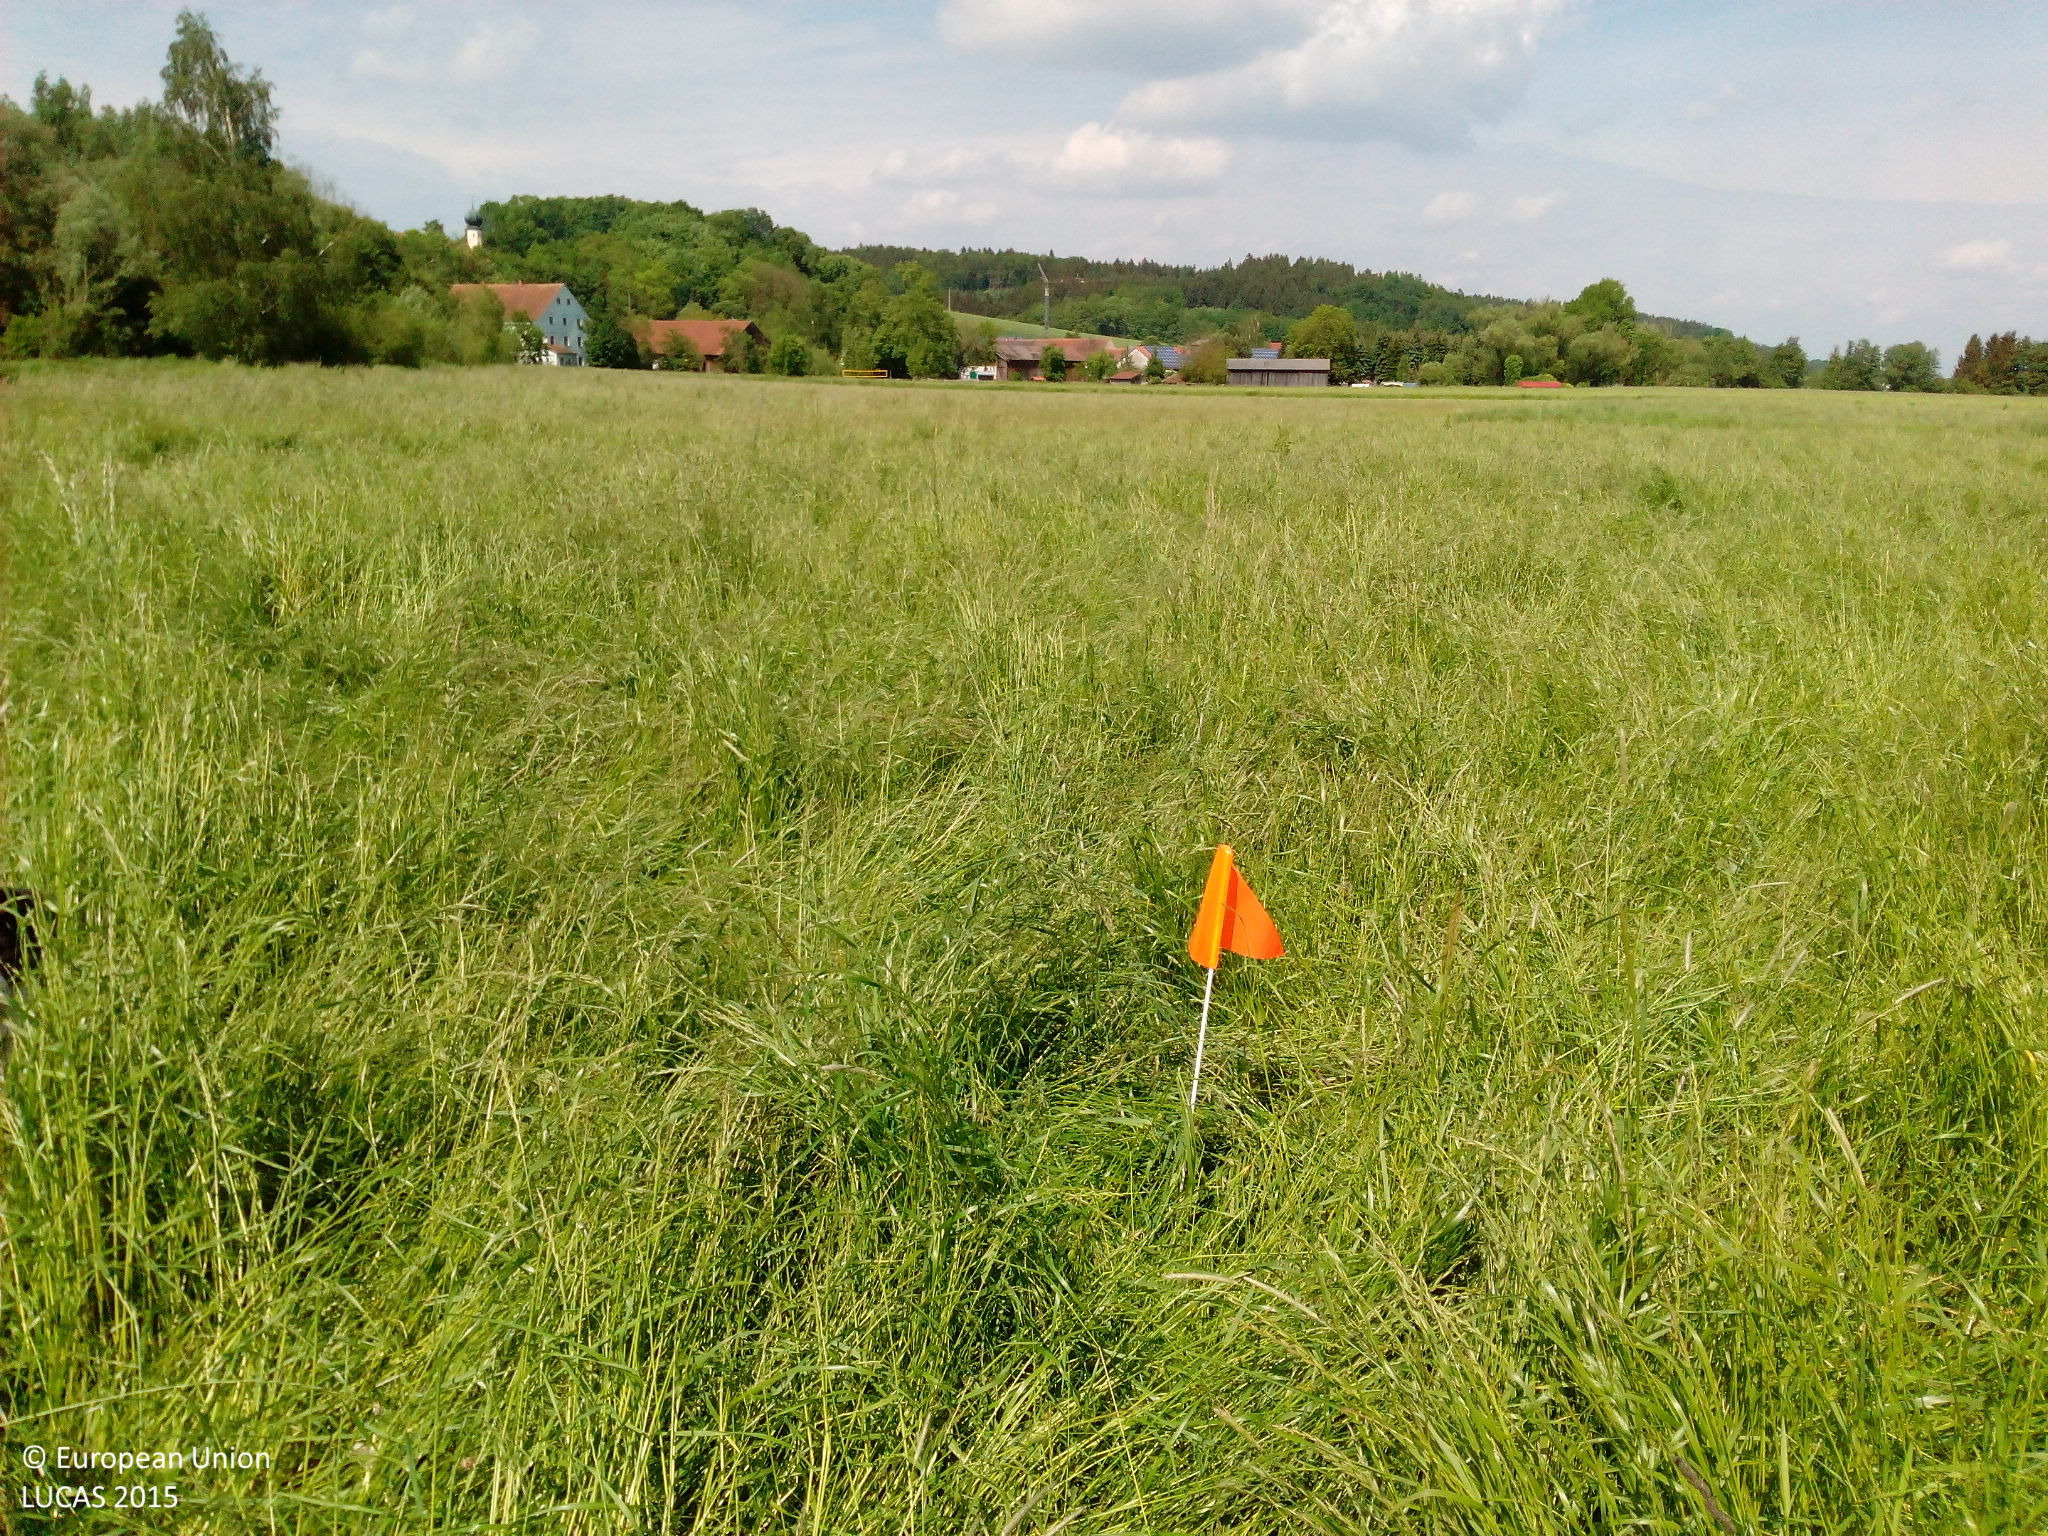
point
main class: Grassland
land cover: Grassland without tree/shrub cover
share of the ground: > 75 %
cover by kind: herbaceous plants 100 %
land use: Agriculture (excluding fallow land and kitchen gardens)
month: May
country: DE
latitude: 48.8110
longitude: 12.3278
